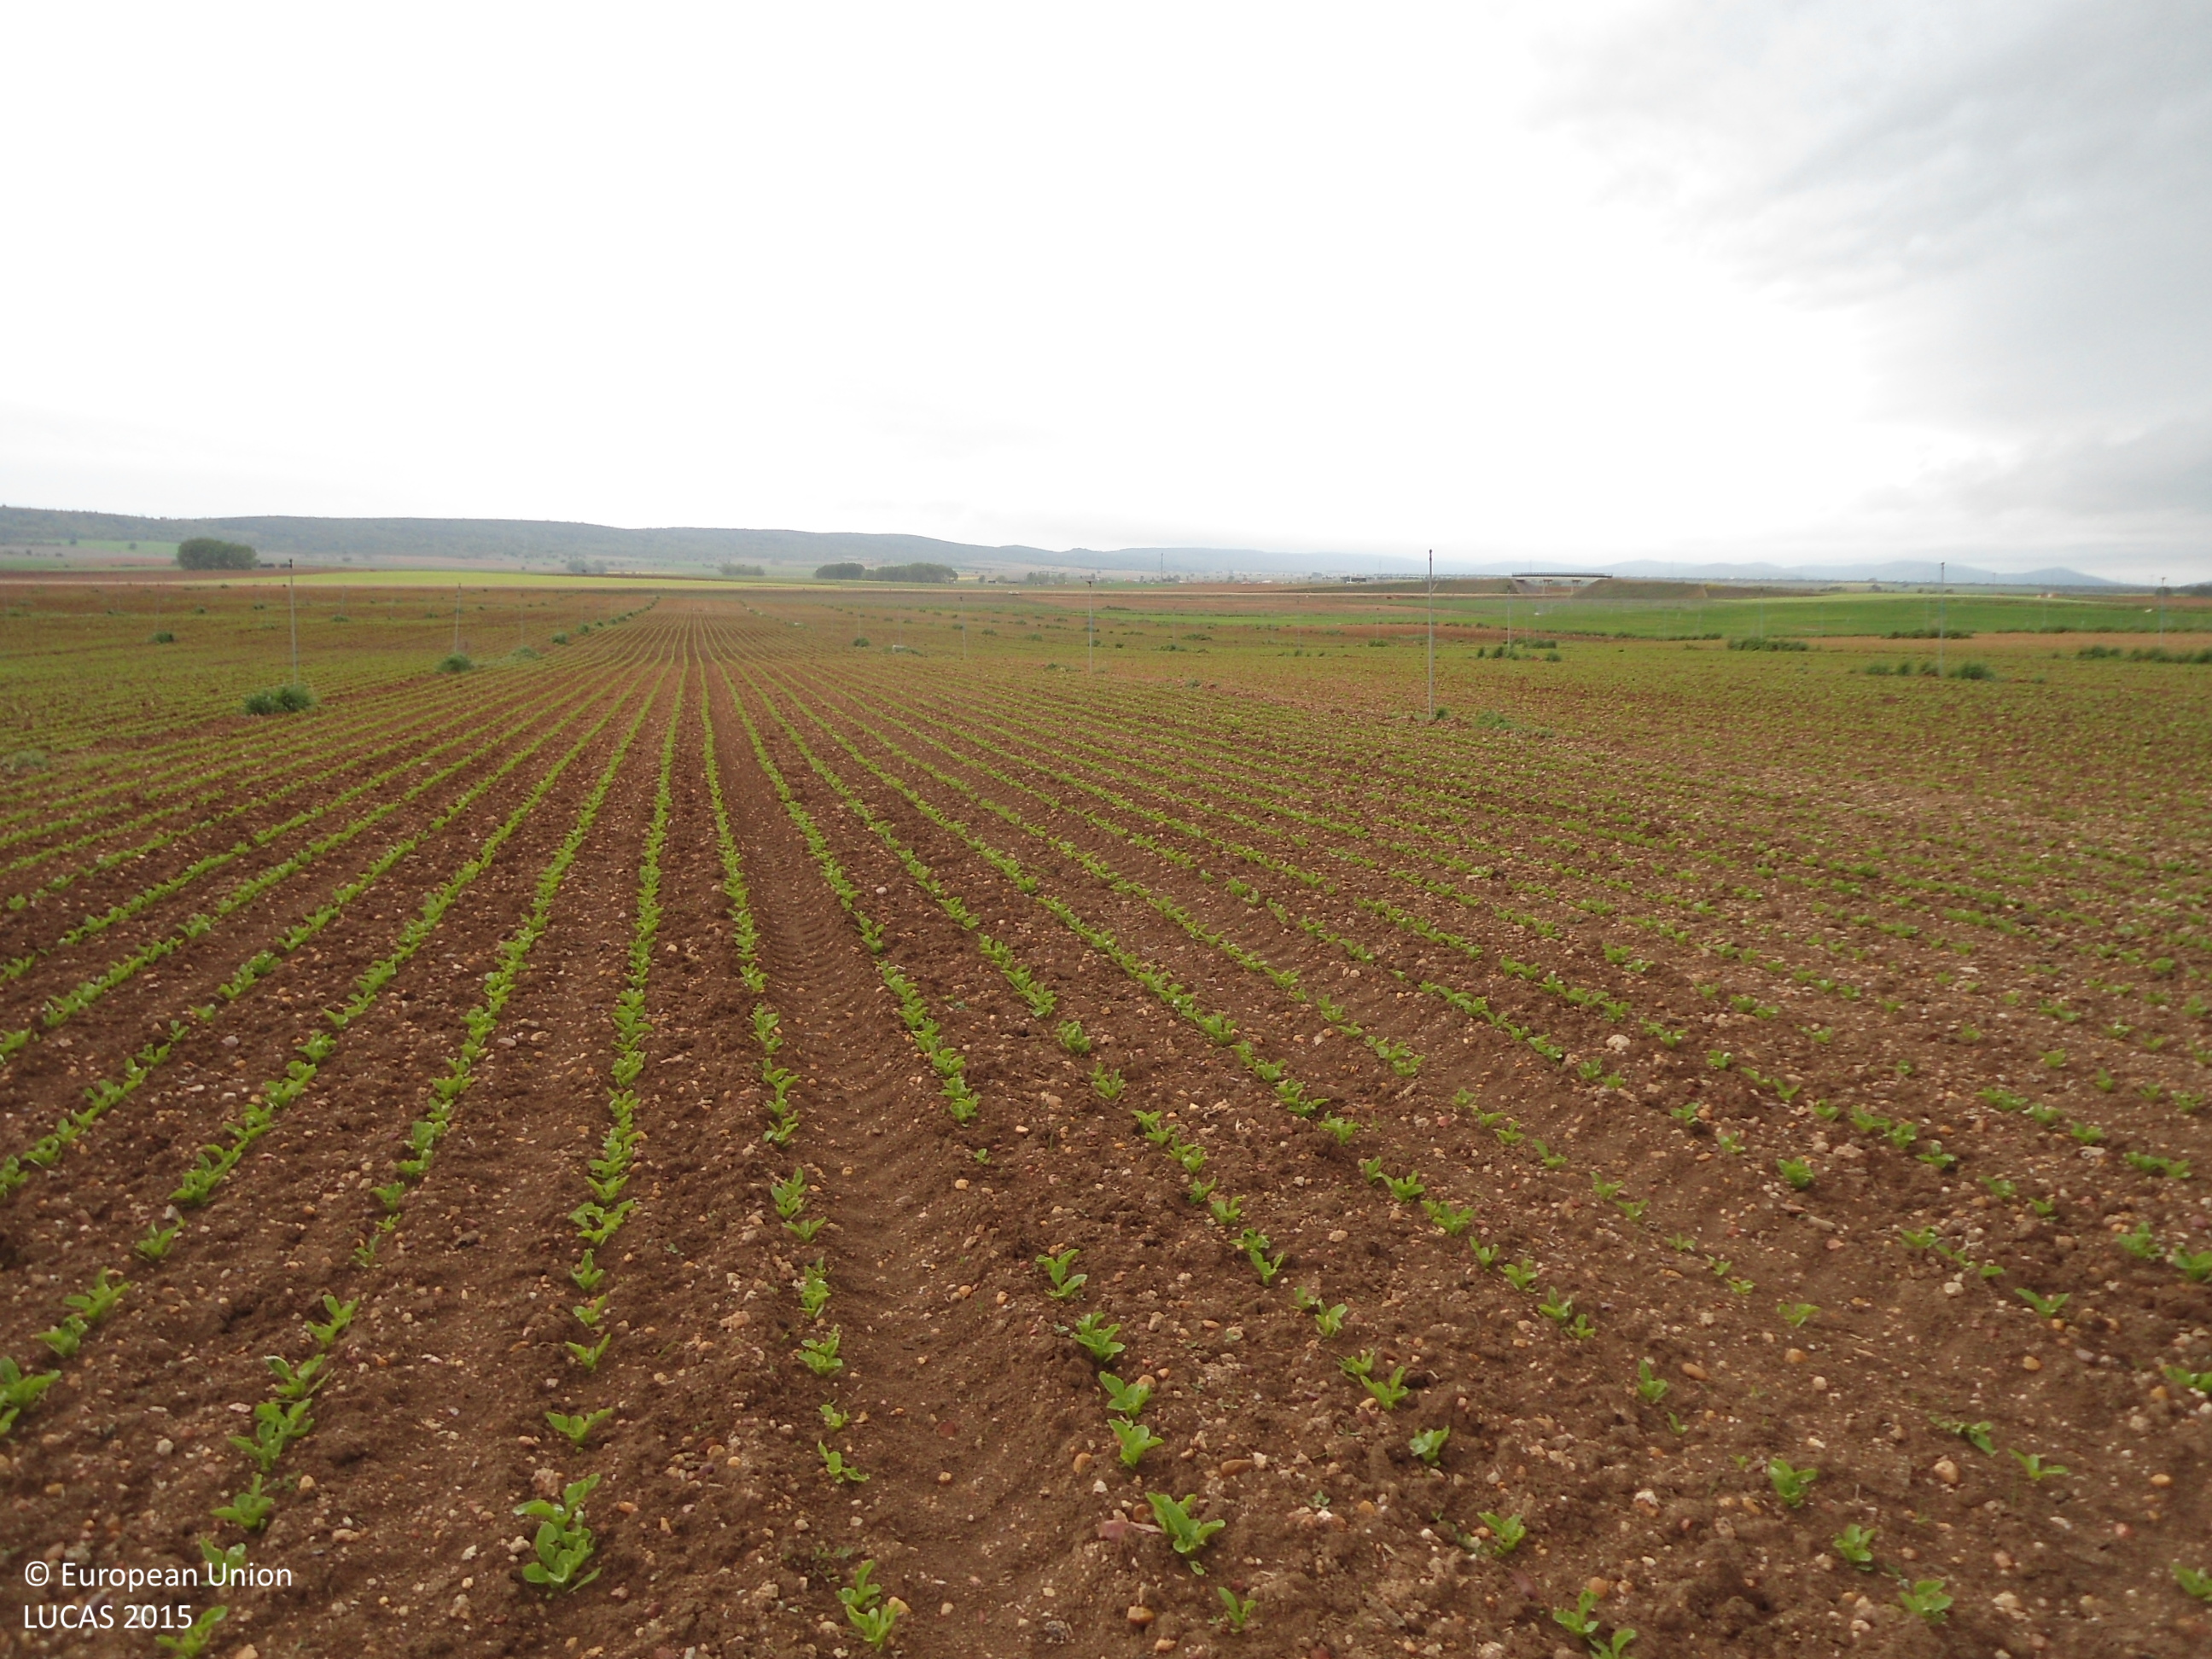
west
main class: Cropland
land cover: Sugar beet
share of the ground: 25 - 50 %
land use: Agriculture (excluding fallow land and kitchen gardens)
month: May
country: ES
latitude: 41.7800
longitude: -5.8660
